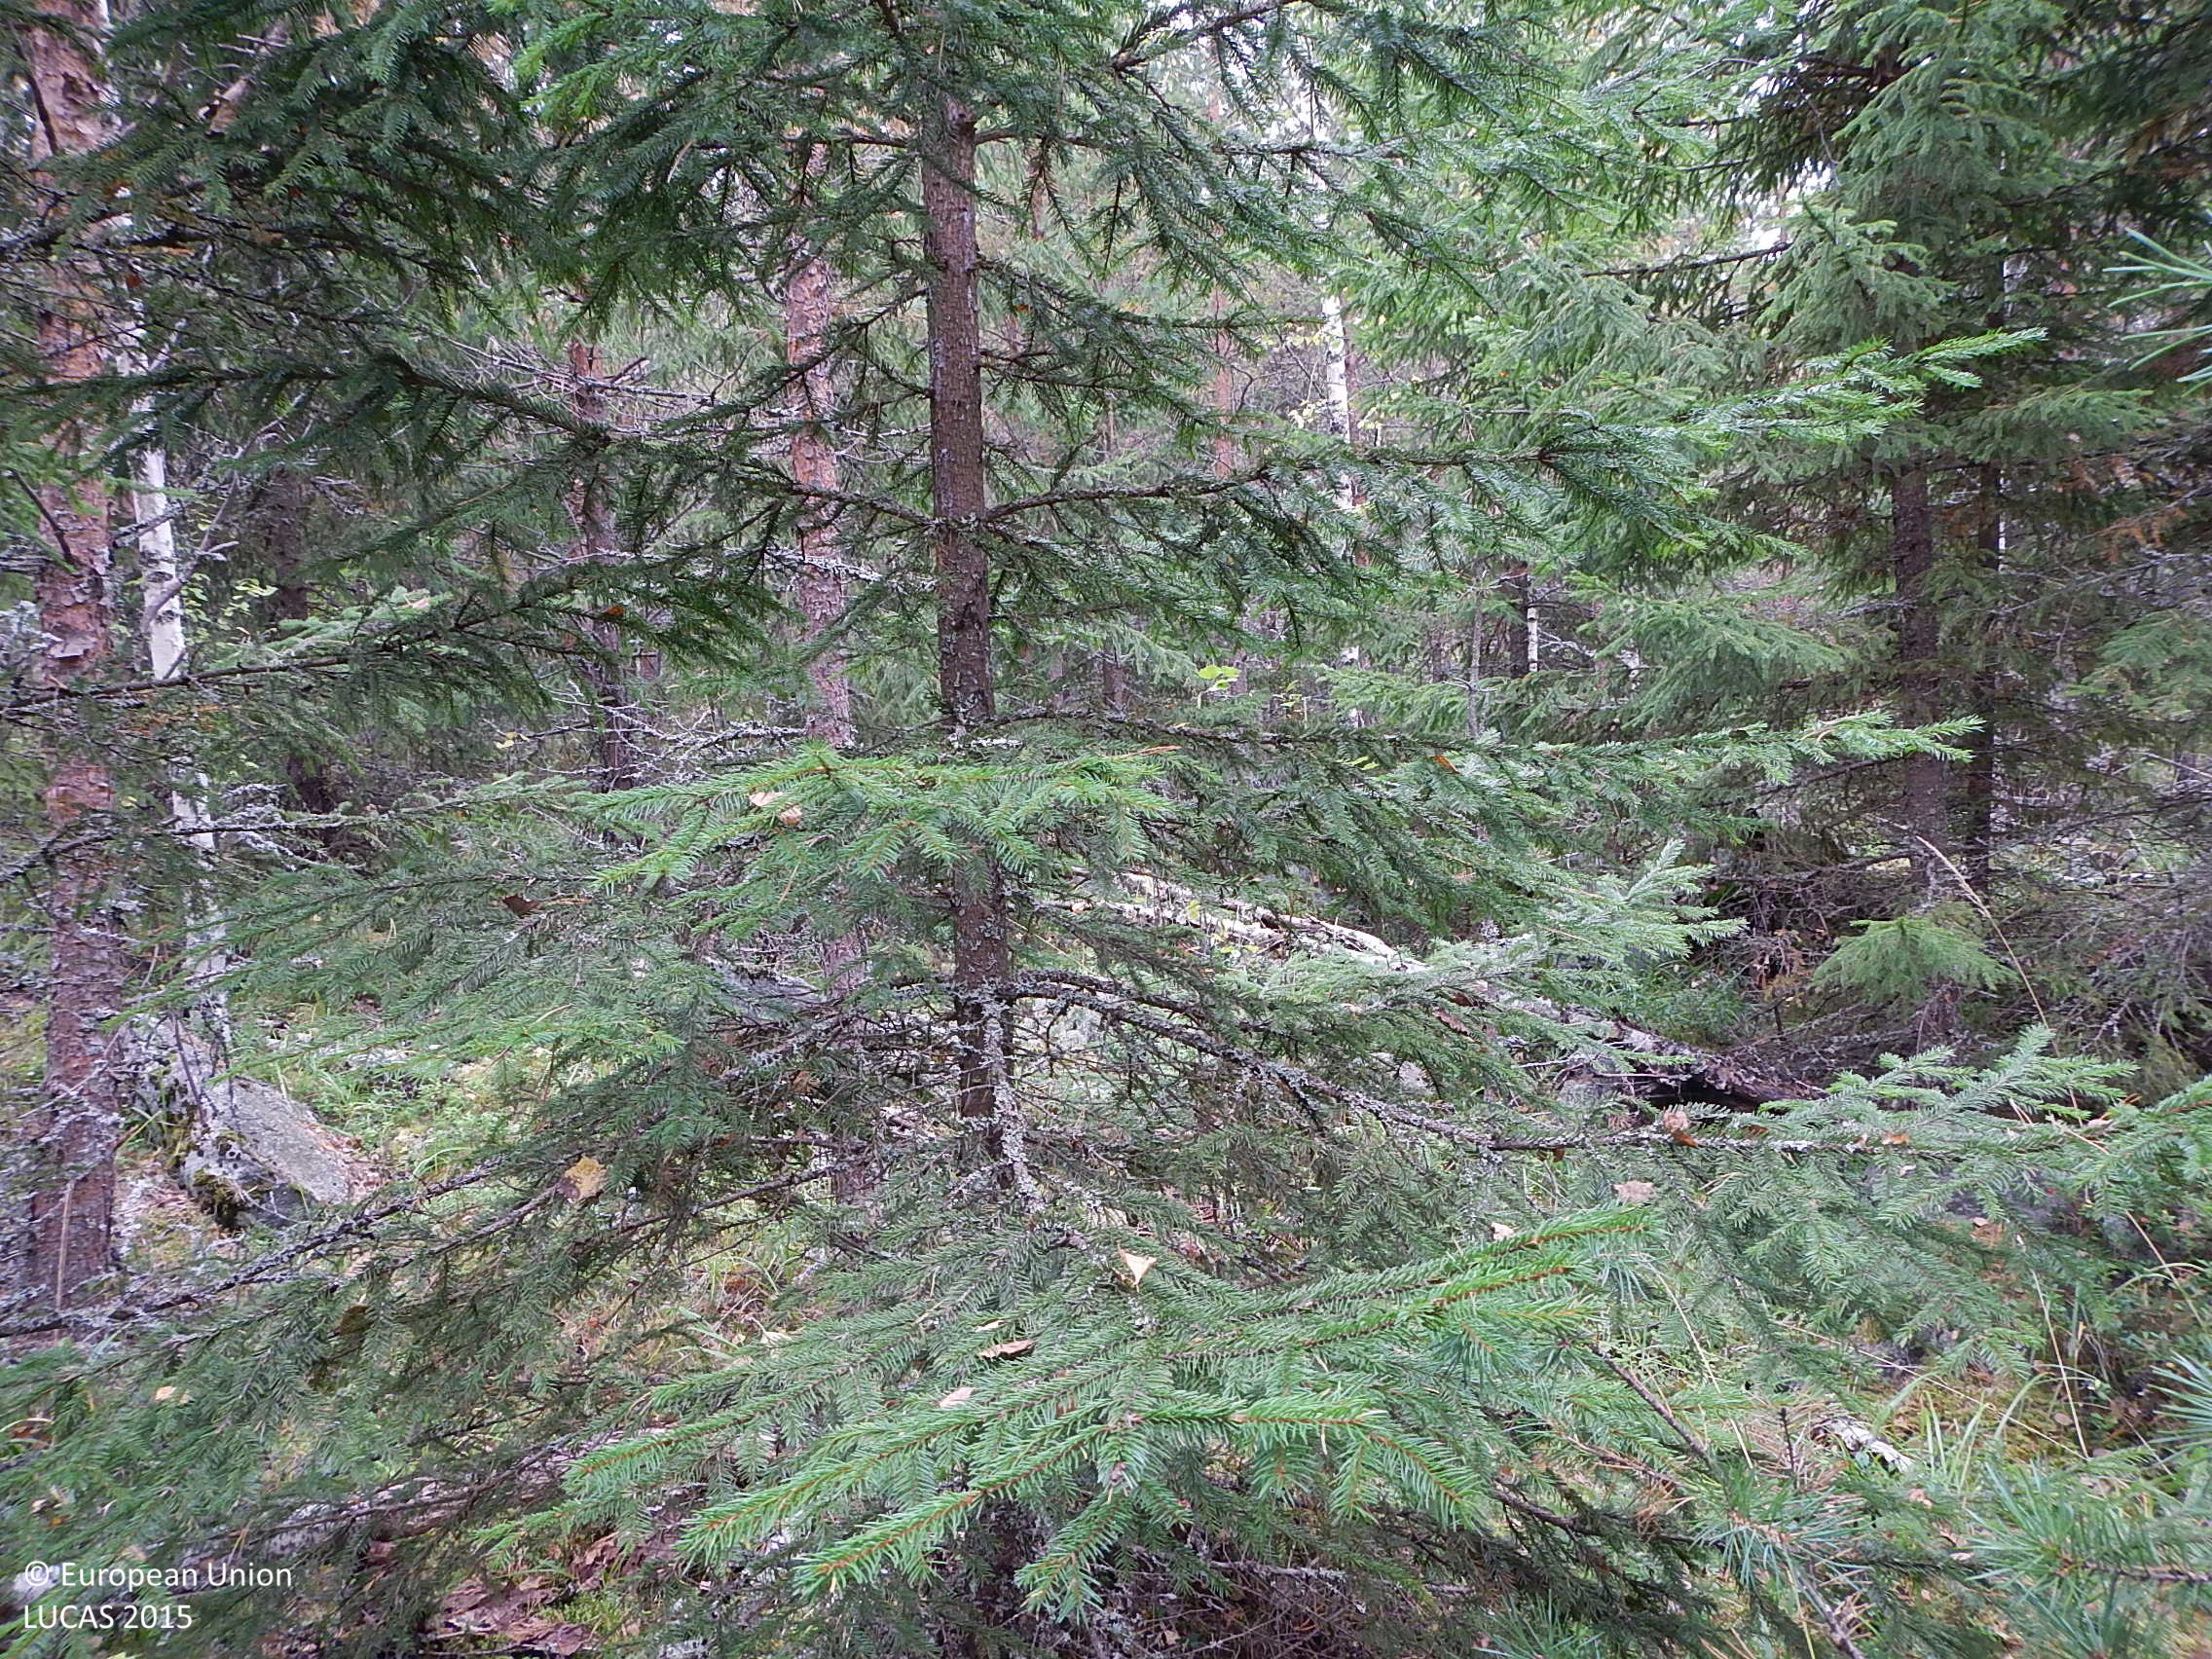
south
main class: Woodland
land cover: Other coniferous woodland
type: boreal forest
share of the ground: > 75 %
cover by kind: coniferous forest trees 60 %, broadleaved forest trees 15 %, shrubs 15 %, herbaceous plants 5 %, lichens and mosses 5 %
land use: Forestry
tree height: > 5 m
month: September
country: FI
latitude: 61.5426
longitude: 22.0404
